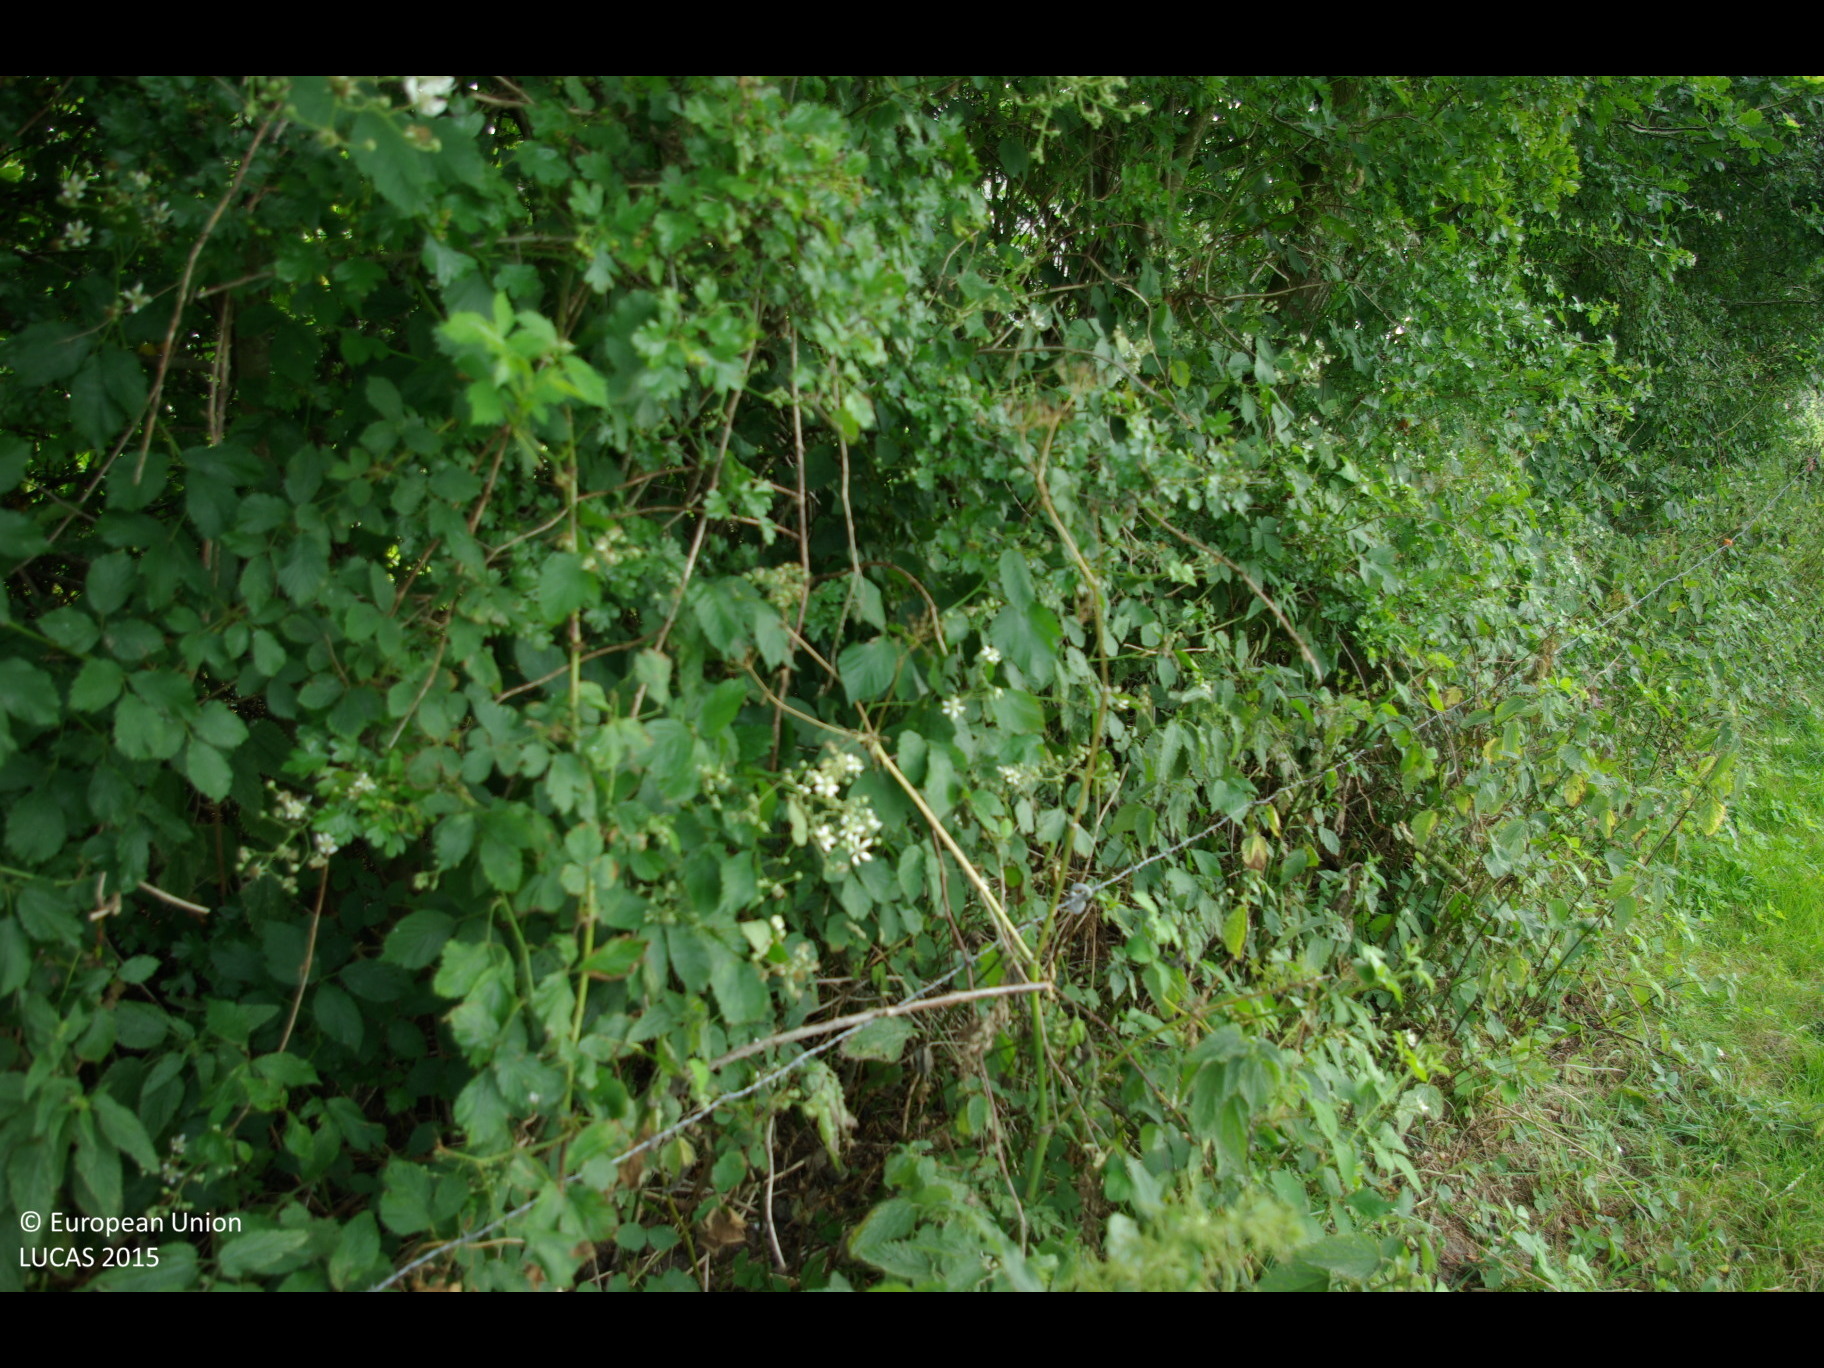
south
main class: Grassland
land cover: Grassland without tree/shrub cover
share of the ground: > 75 %
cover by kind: herbaceous plants 100 %
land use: Agriculture (excluding fallow land and kitchen gardens)
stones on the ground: < 10 %
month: July
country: DE
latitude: 54.2627
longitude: 9.3096
